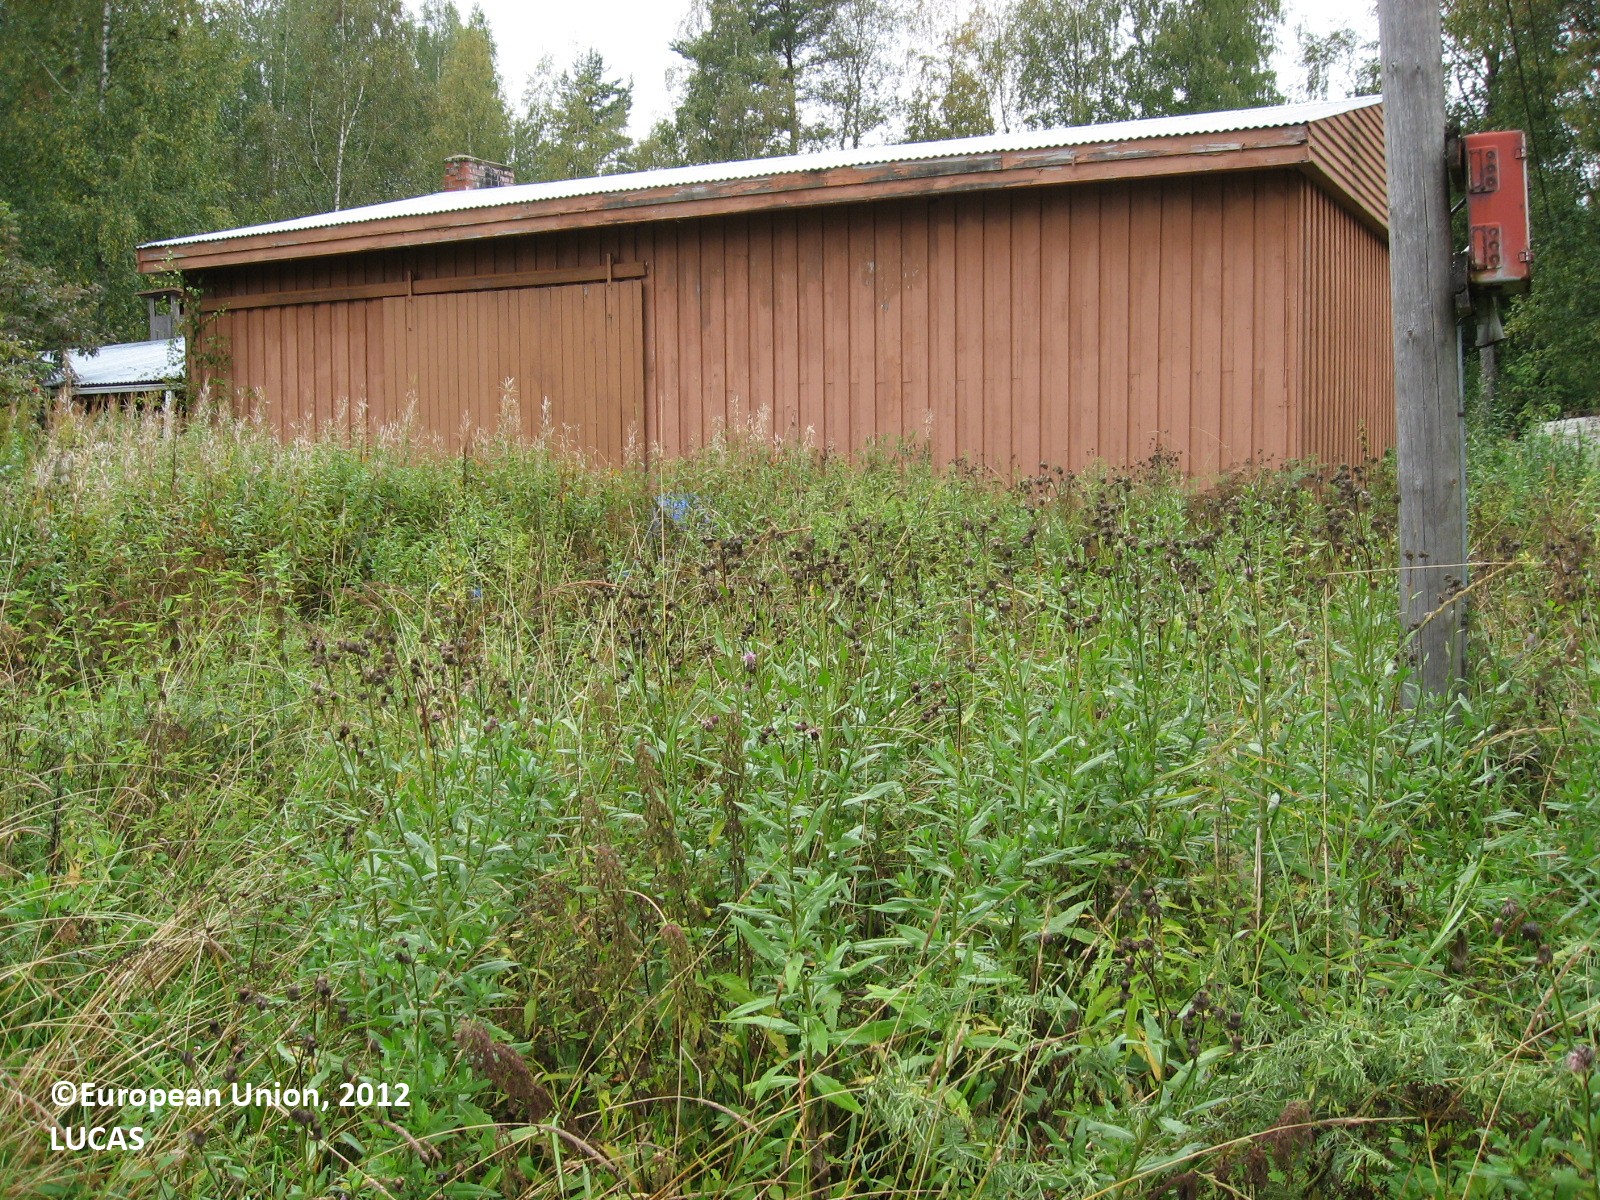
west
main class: Cropland
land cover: Oats
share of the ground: > 75 %
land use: Agriculture (excluding fallow land and kitchen gardens)
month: August
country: FI
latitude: 61.4351
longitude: 24.7846
